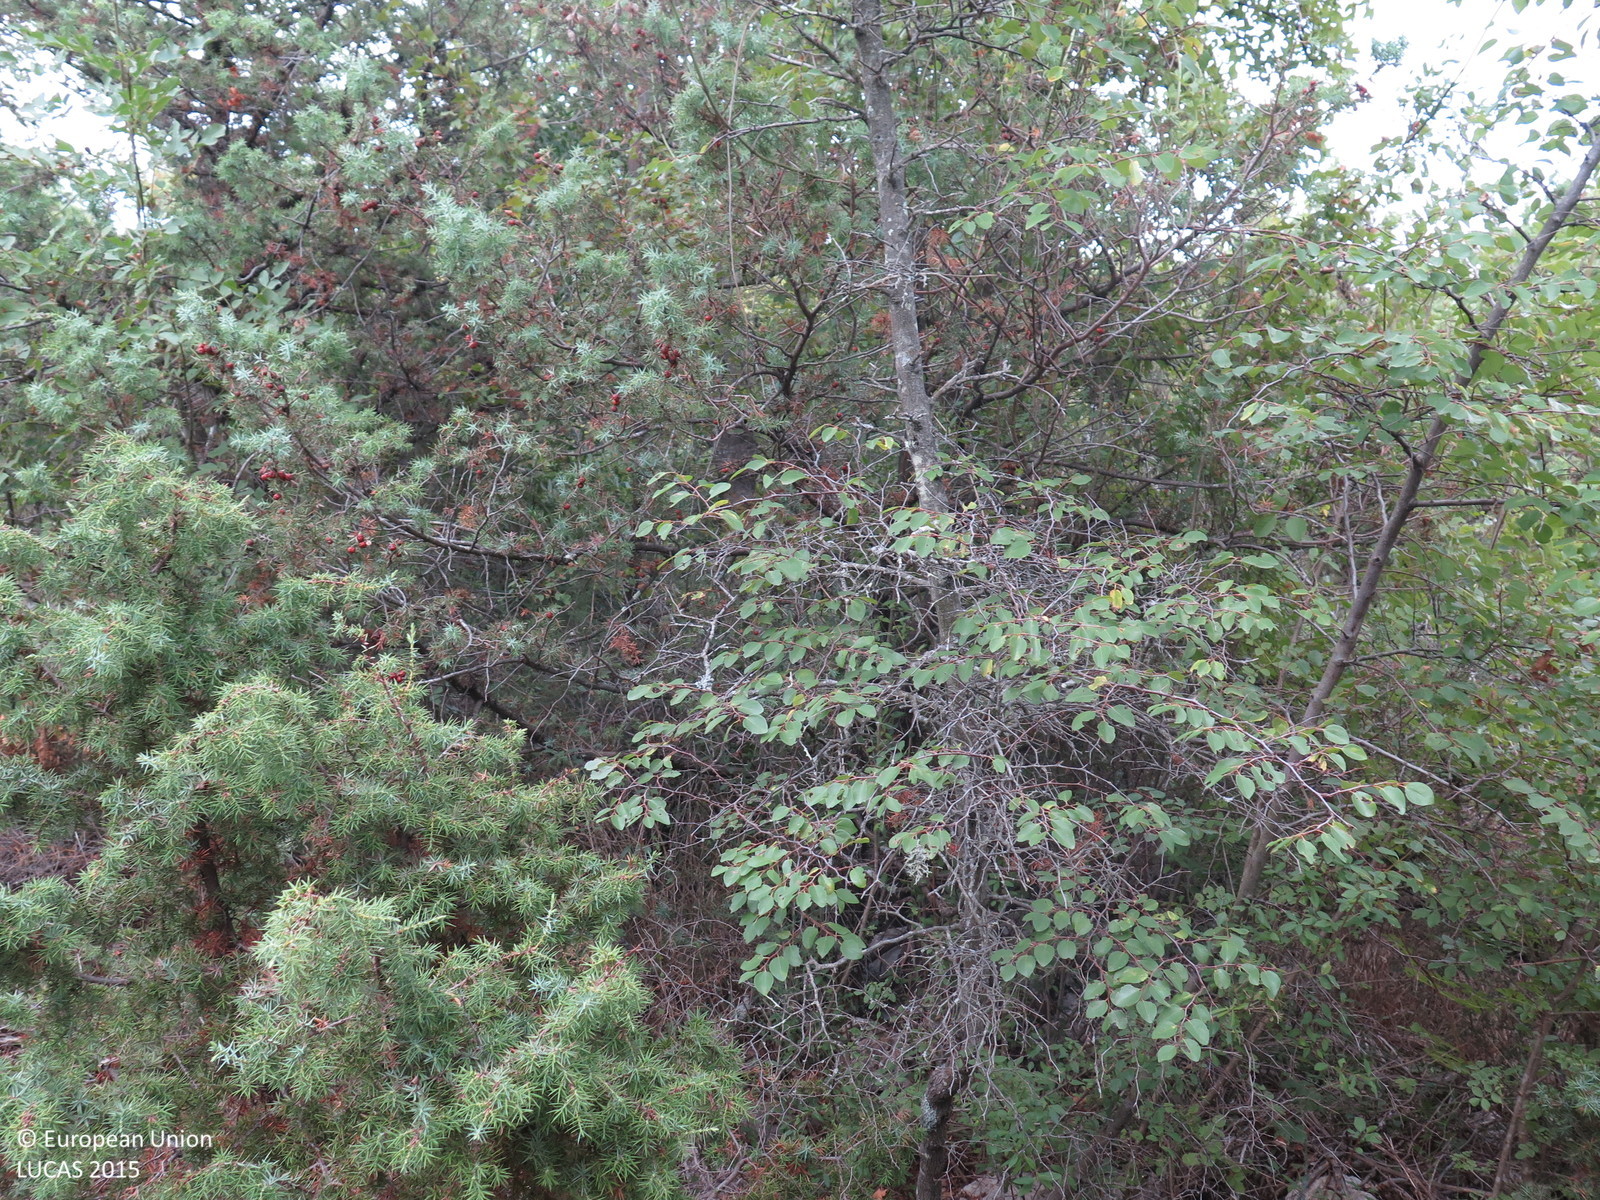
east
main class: Shrubland
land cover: Shrubland with sparse tree cover
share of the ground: > 75 %
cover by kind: shrubs 90 %, broadleaved forest trees 5 %, herbaceous plants 5 %
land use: Semi-natural and natural areas not in use
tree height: < 5 m
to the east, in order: Shrubland with sparse tree cover; Dry stone walls; Shrubland with sparse tree cover; Rocks and stones; Grass margins; Tracks; Rocks and stones; Broadleaved woodland; Tracks; Rocks and stones; Broadleaved woodland; Rocks and stones; Broadleaved woodland; Rocks and stones; Tracks; Single bushes/trees; Dry stone walls
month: August
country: HR
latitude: 45.0599
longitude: 14.6296
